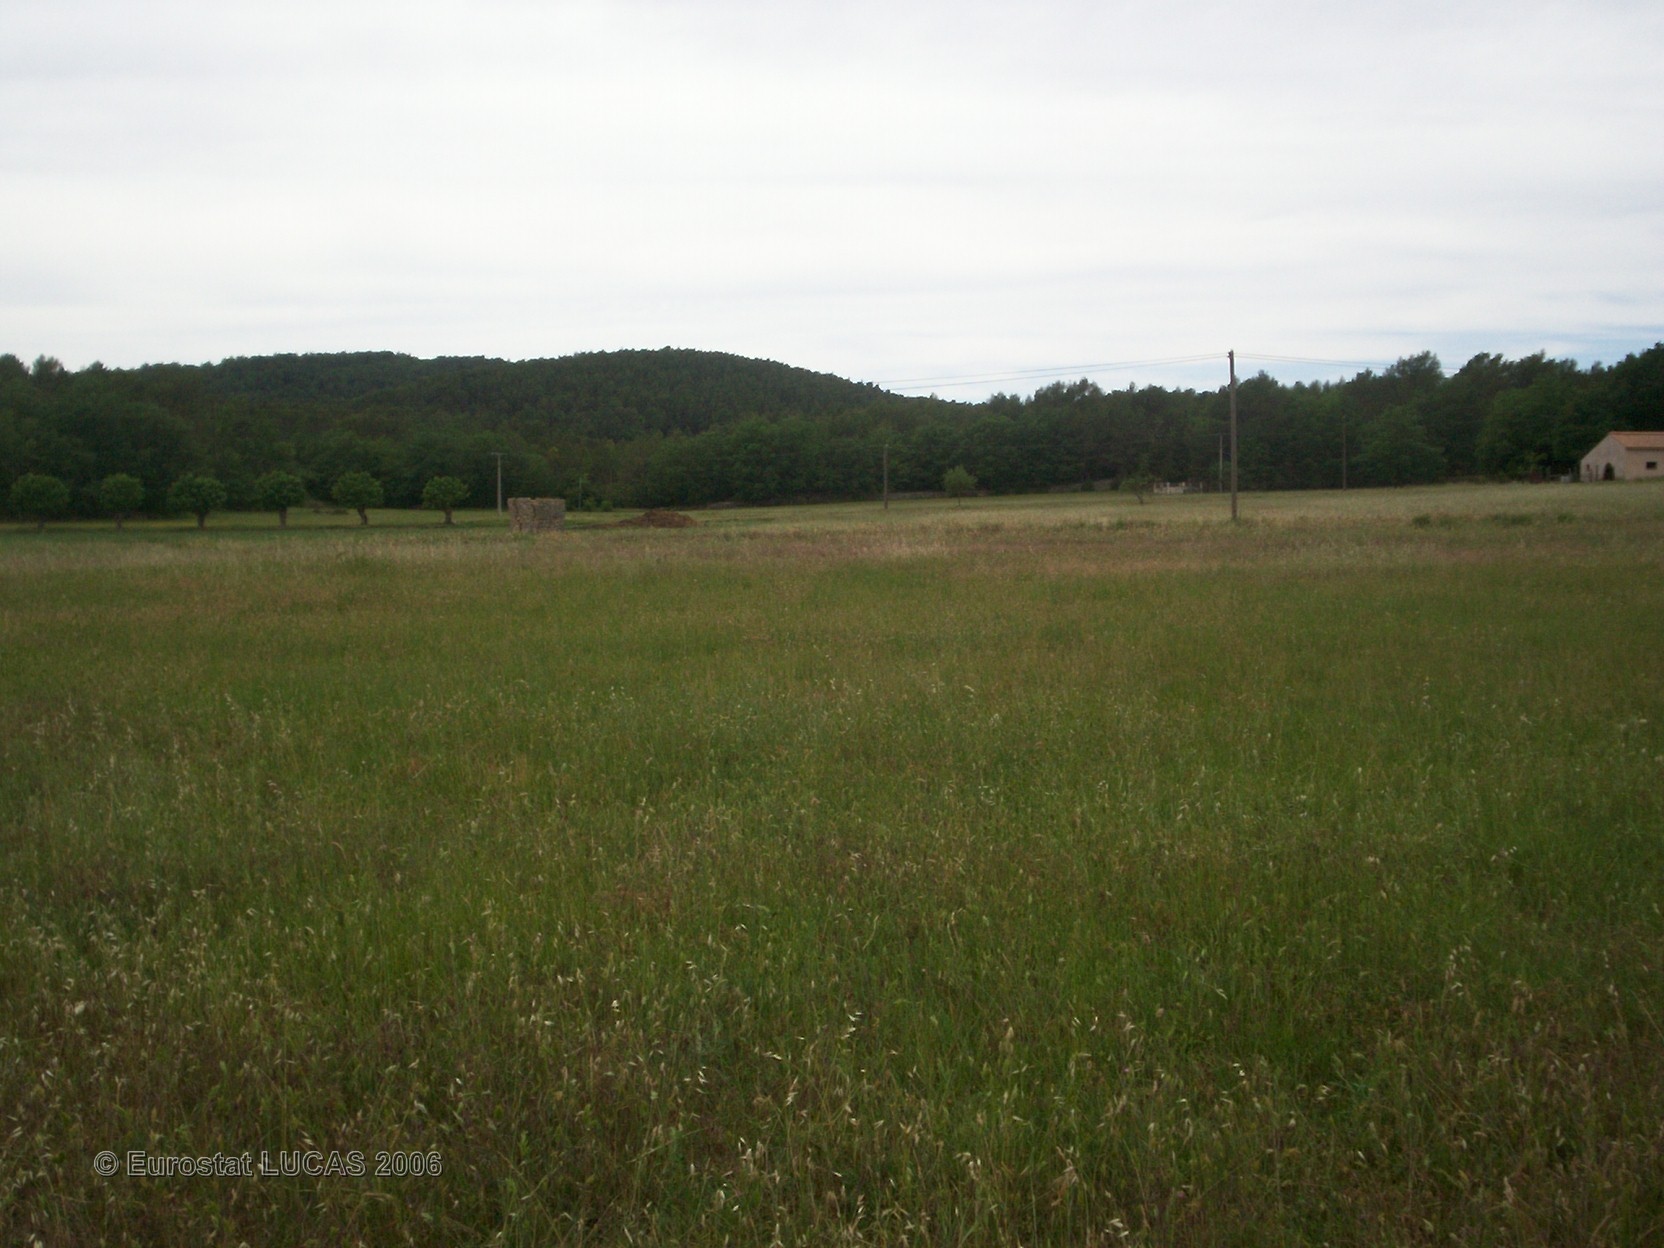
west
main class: Grassland
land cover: Grassland without tree/shrub cover
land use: Agriculture (excluding fallow land and kitchen gardens)
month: May
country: FR
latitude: 43.5711
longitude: 6.5537
